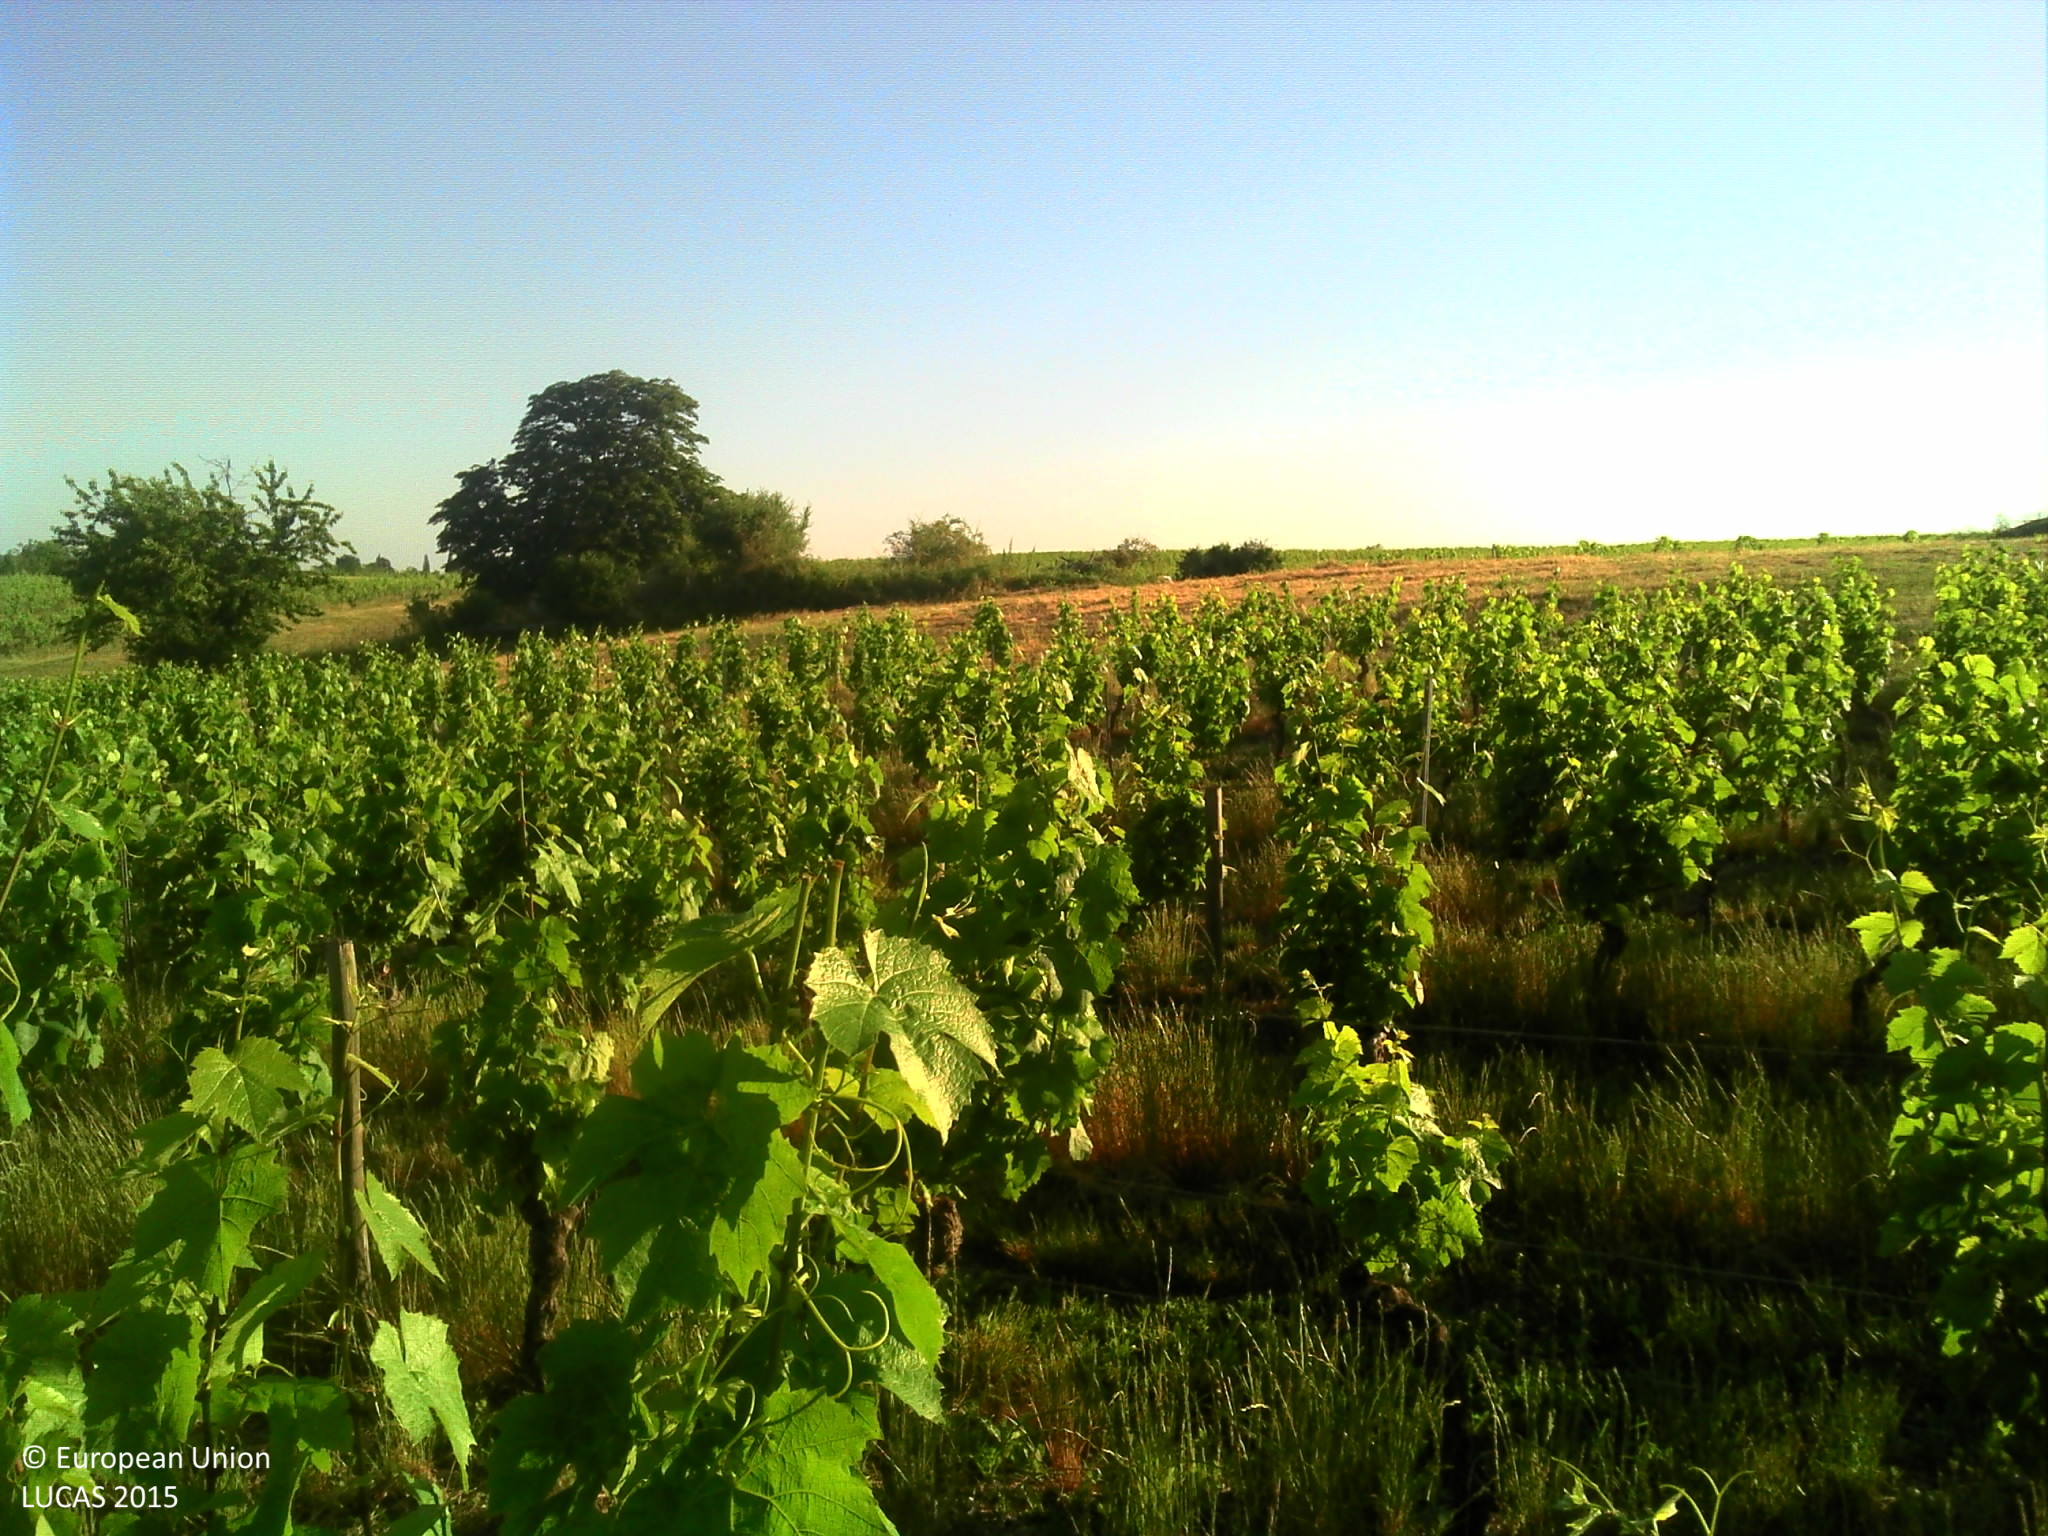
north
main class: Cropland
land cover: Vineyards
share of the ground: 10 - 25 %
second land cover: Spontaneously vegetated surfaces
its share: > 75 %
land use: Agriculture (excluding fallow land and kitchen gardens)
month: June
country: FR
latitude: 44.0179
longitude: 1.9315
